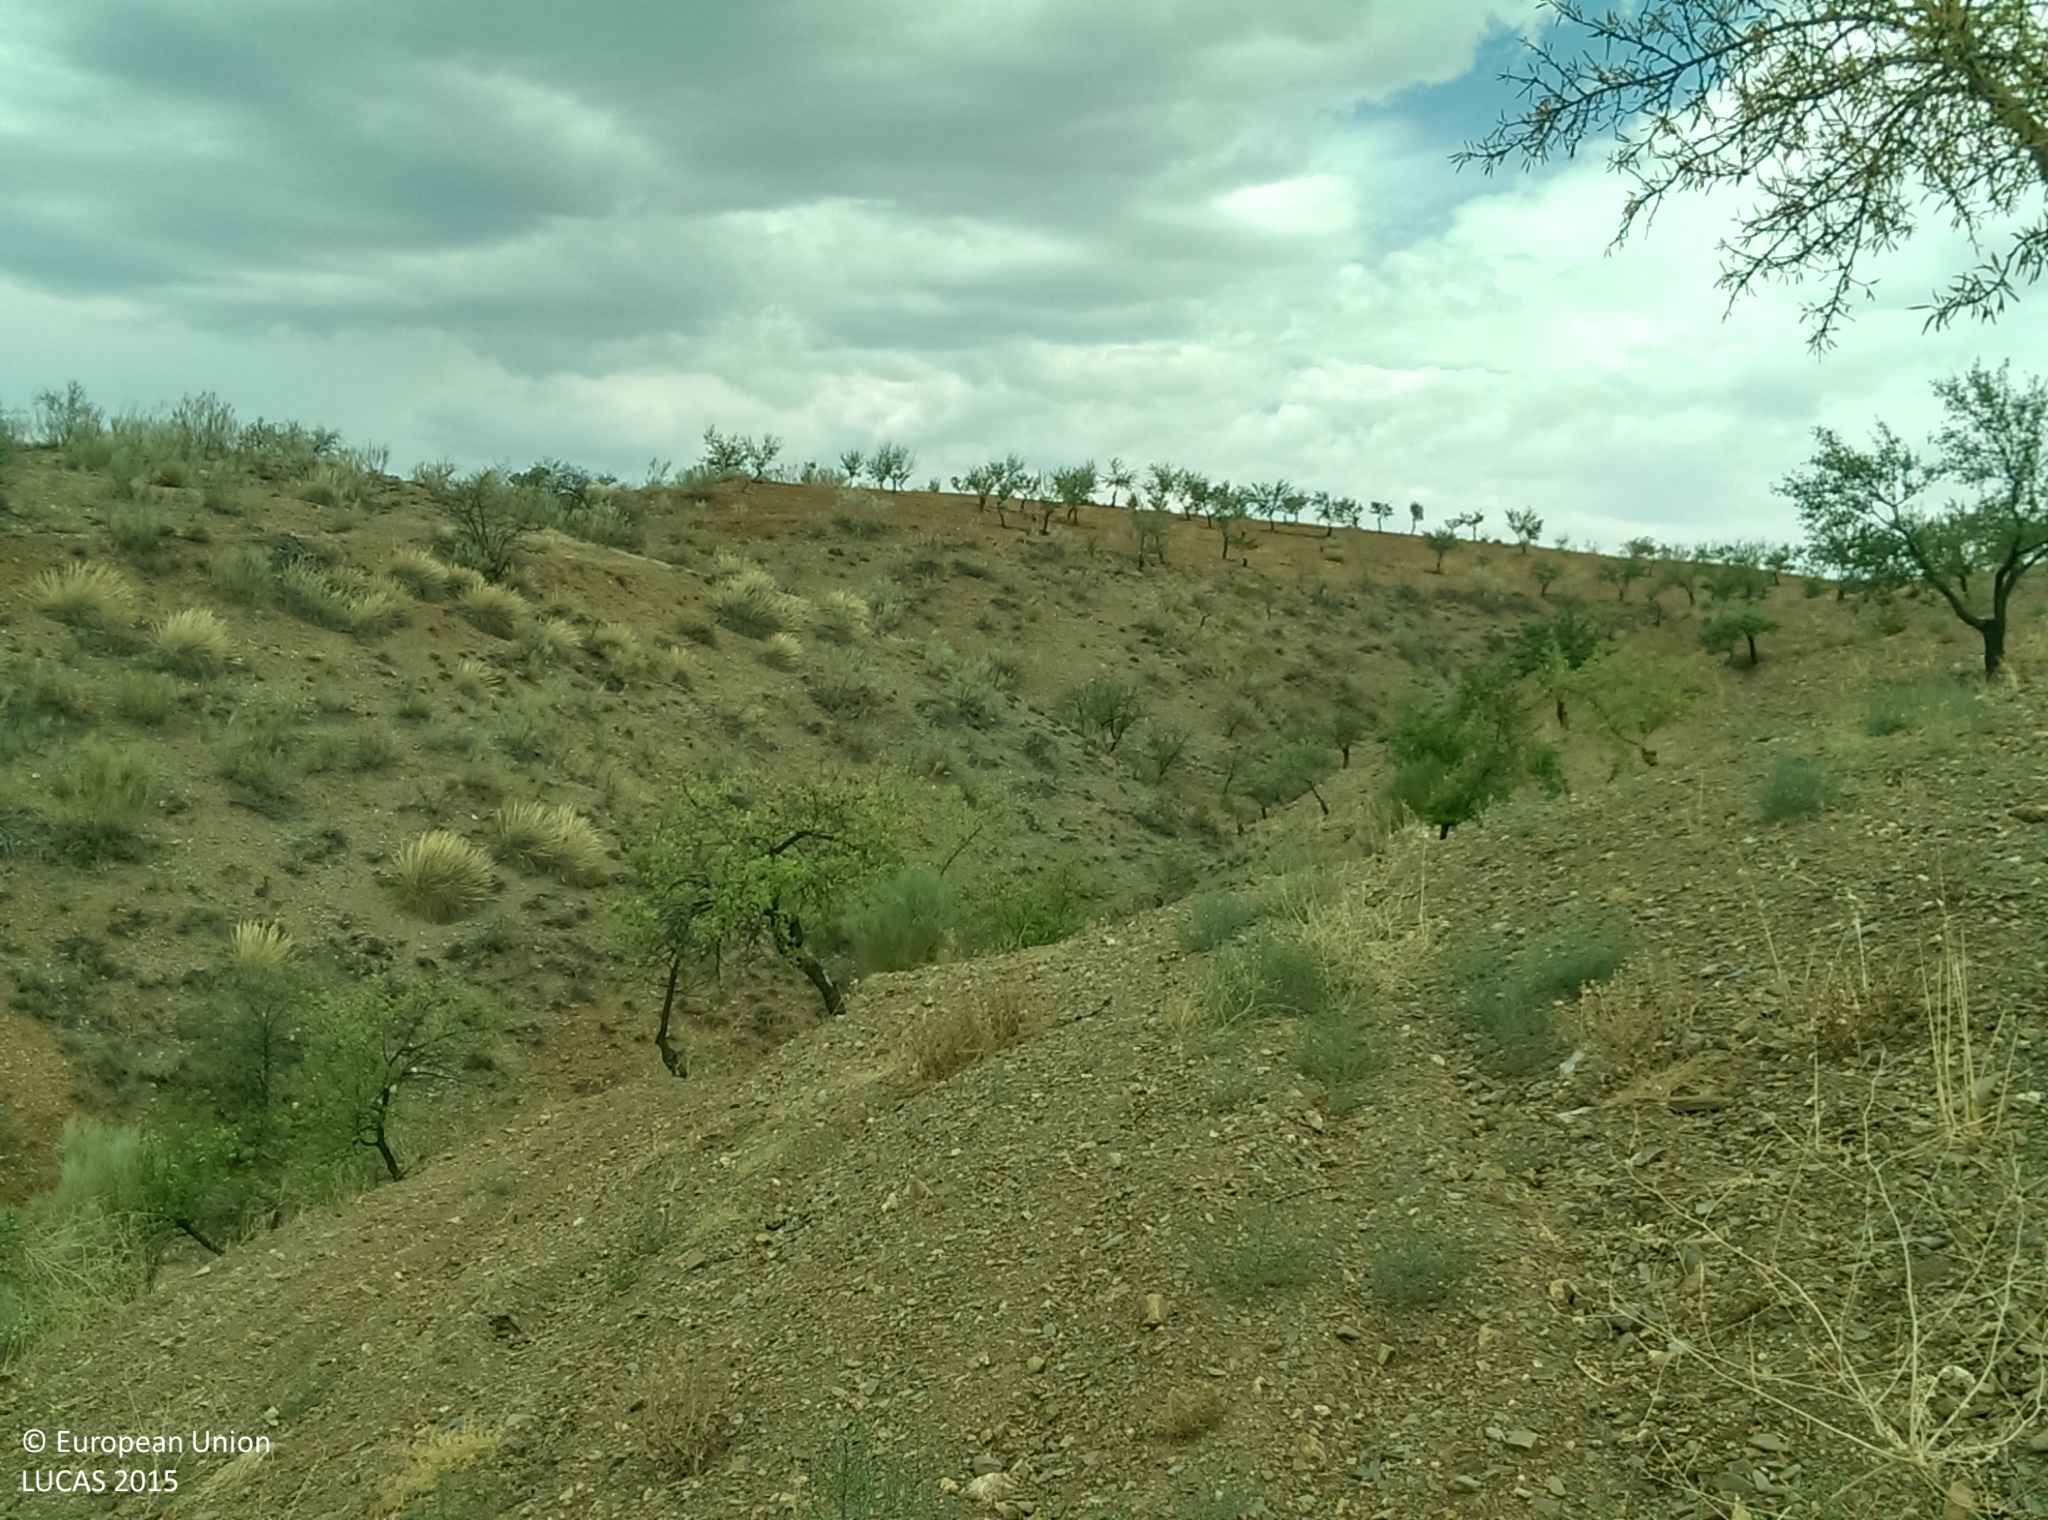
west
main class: Cropland
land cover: Nuts trees
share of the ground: < 10 %
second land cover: Spontaneously vegetated surfaces
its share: 10 - 25 %
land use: Agriculture (excluding fallow land and kitchen gardens)
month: July
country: ES
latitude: 37.1943
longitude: -2.9054
